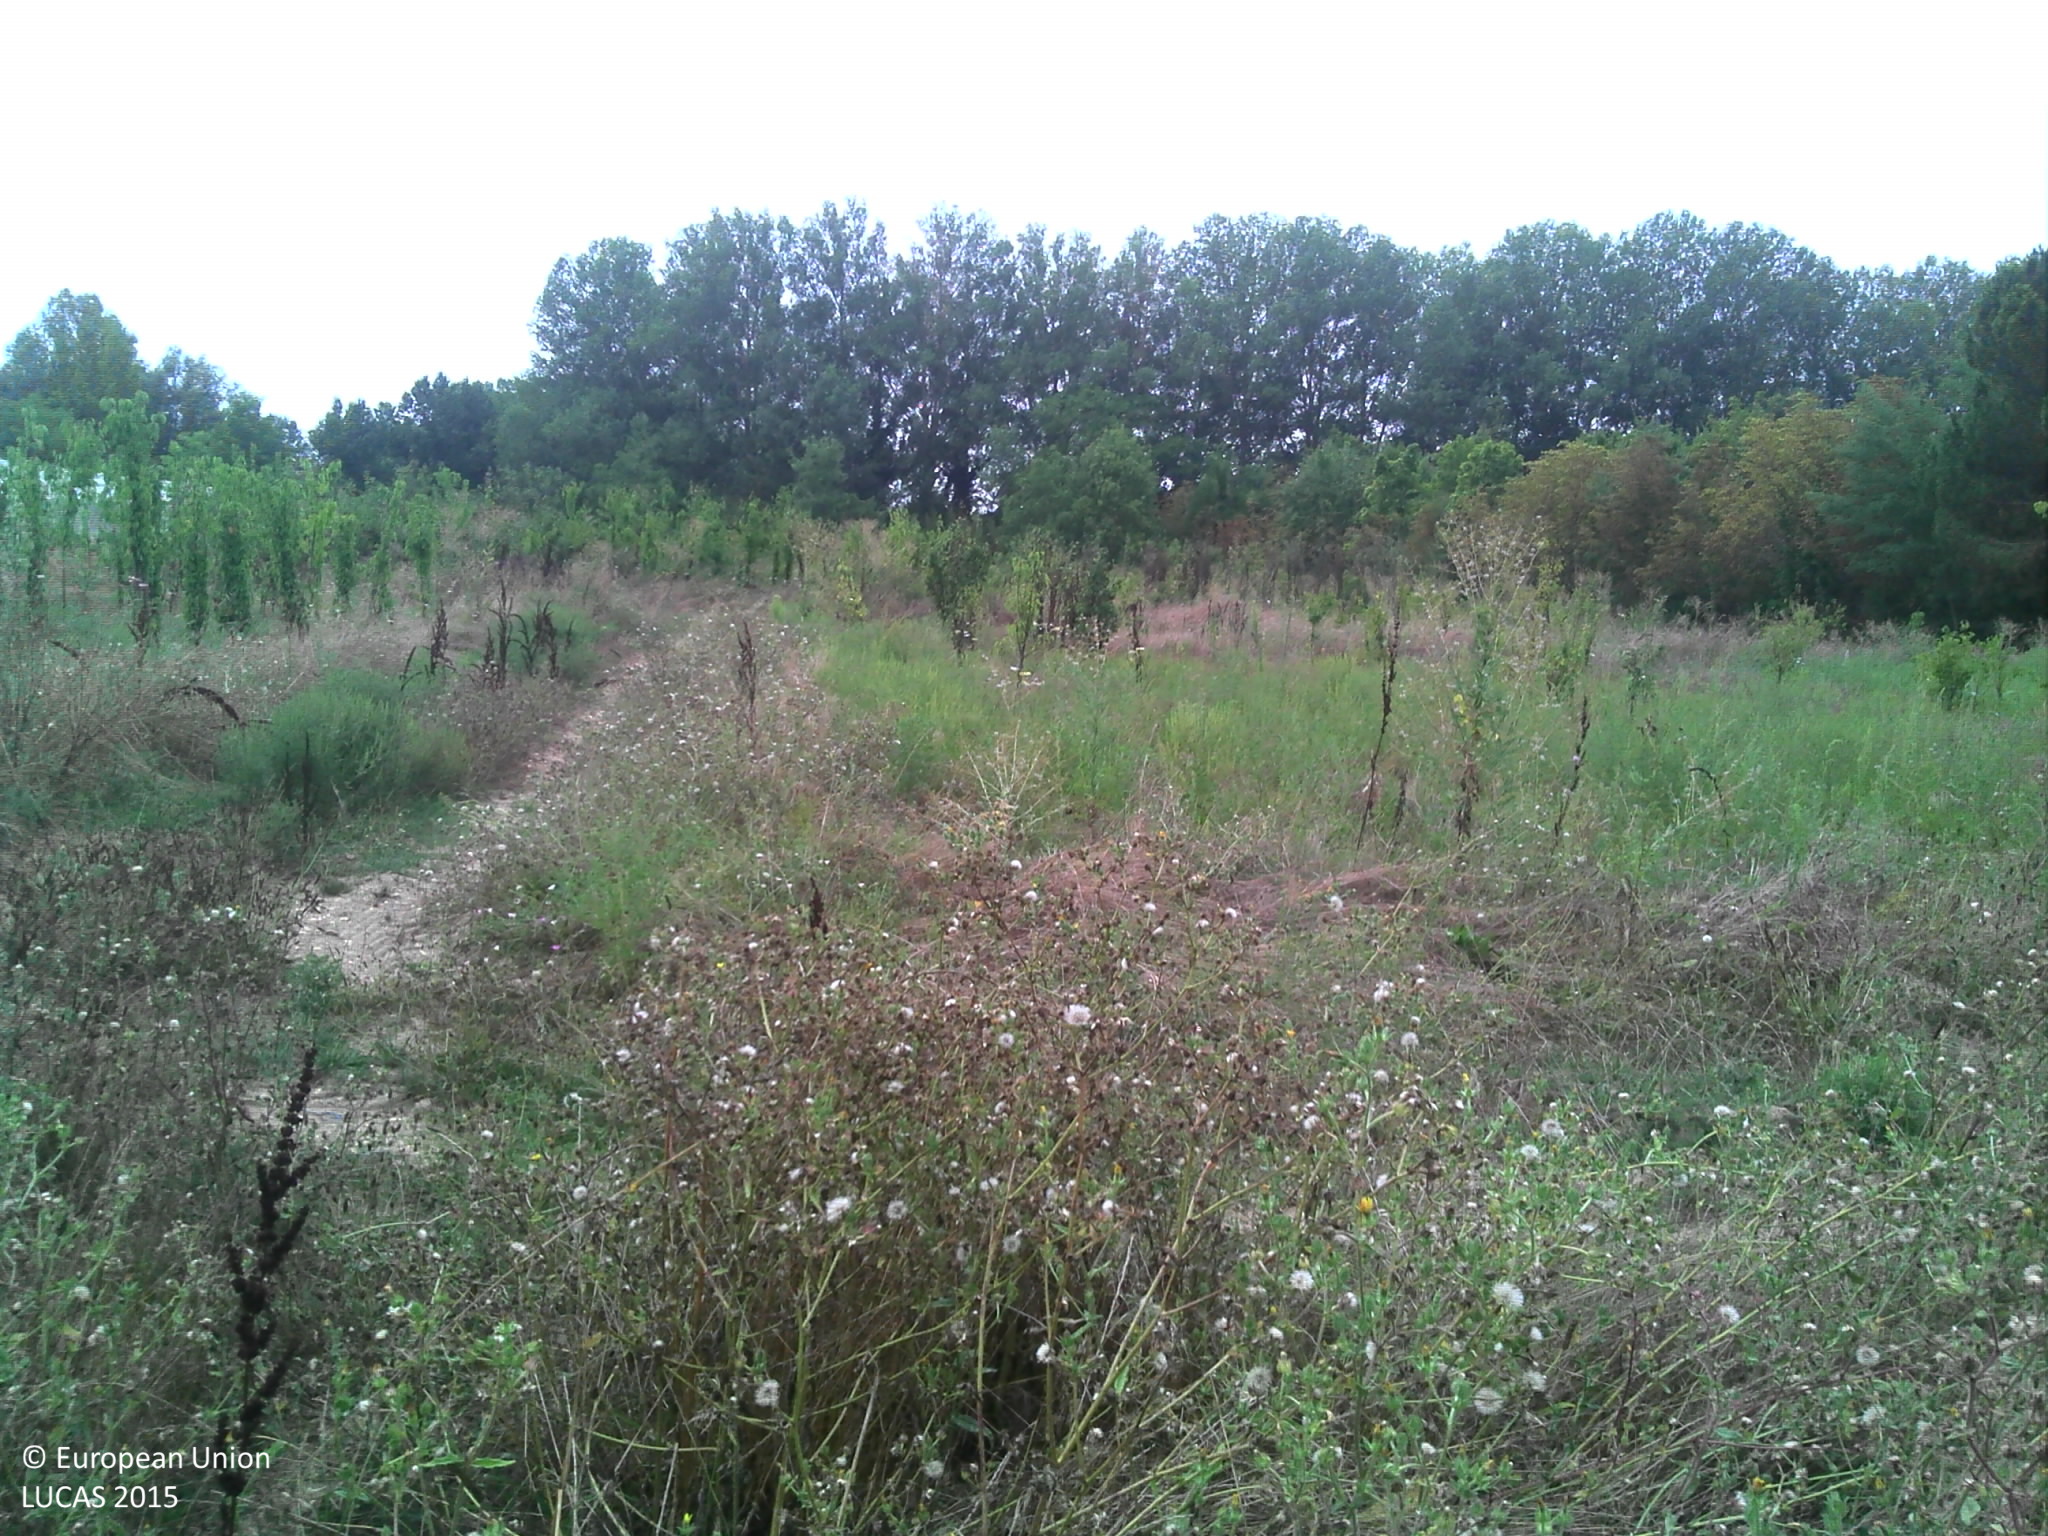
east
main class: Grassland
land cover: Spontaneously vegetated surfaces
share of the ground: > 75 %
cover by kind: herbaceous plants 100 %
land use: Fallow land
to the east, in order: Spontaneously vegetated surfaces; Electric lines; Tracks; Lines of trees; Ditches and canals; Lines of trees; Electric lines; Paved roads, cycling and walking lanes; Pear fruit
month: August
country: FR
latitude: 43.9359
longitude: 1.3674
